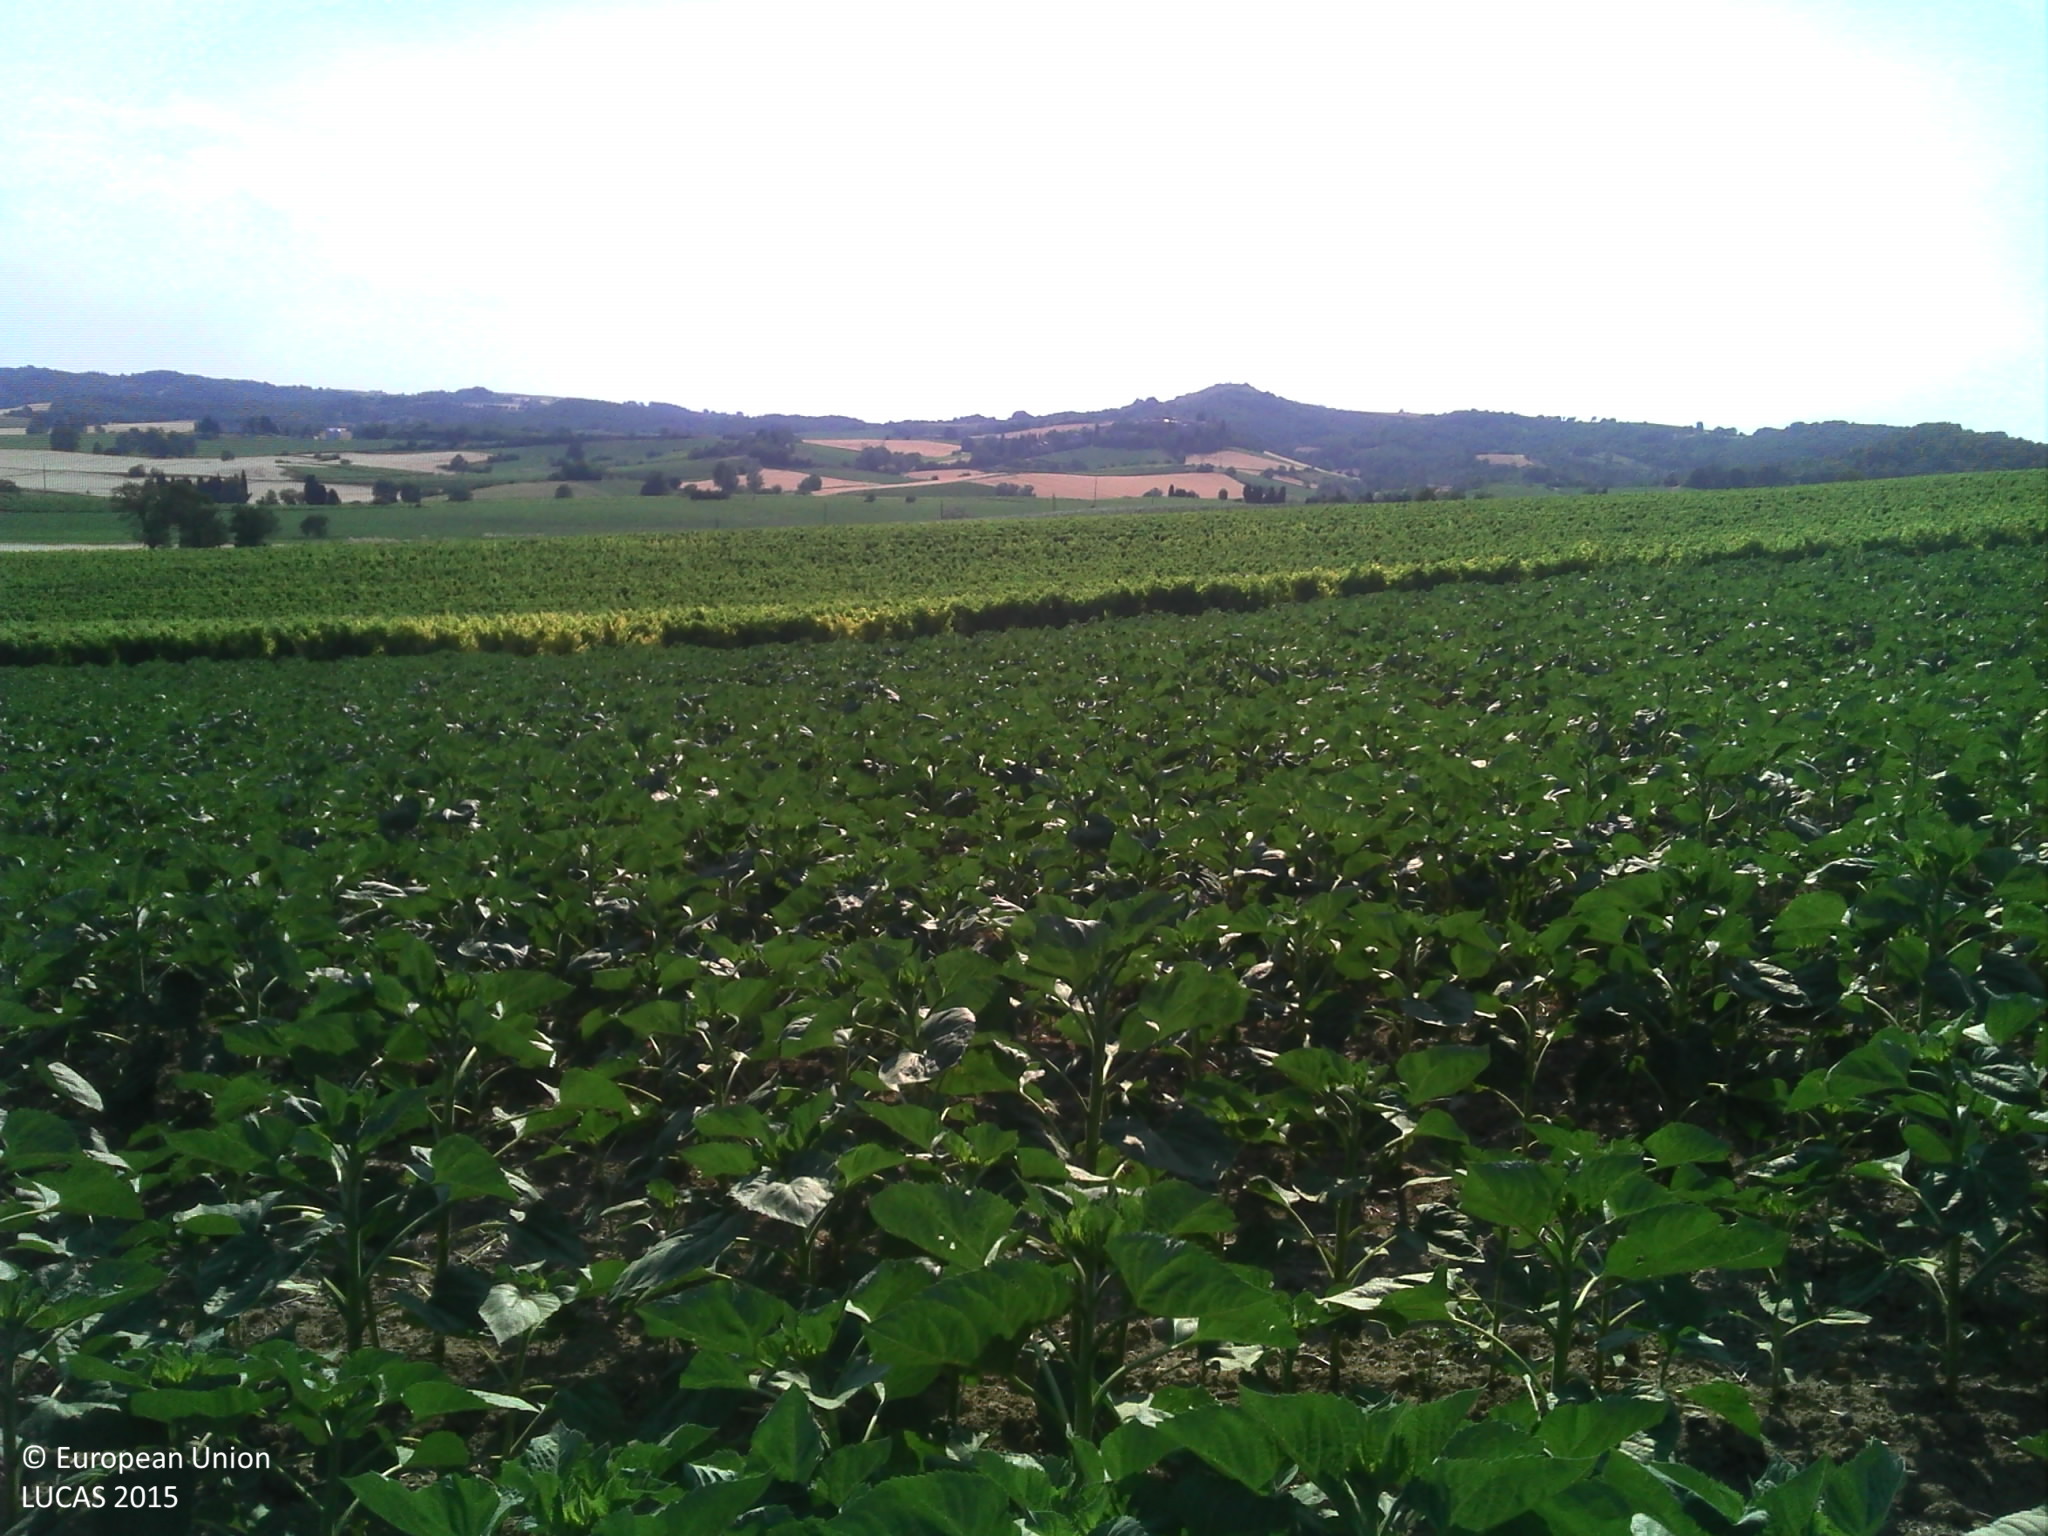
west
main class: Cropland
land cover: Sunflower
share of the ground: > 75 %
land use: Agriculture (excluding fallow land and kitchen gardens)
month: June
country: FR
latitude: 43.1572
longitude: 2.0505
